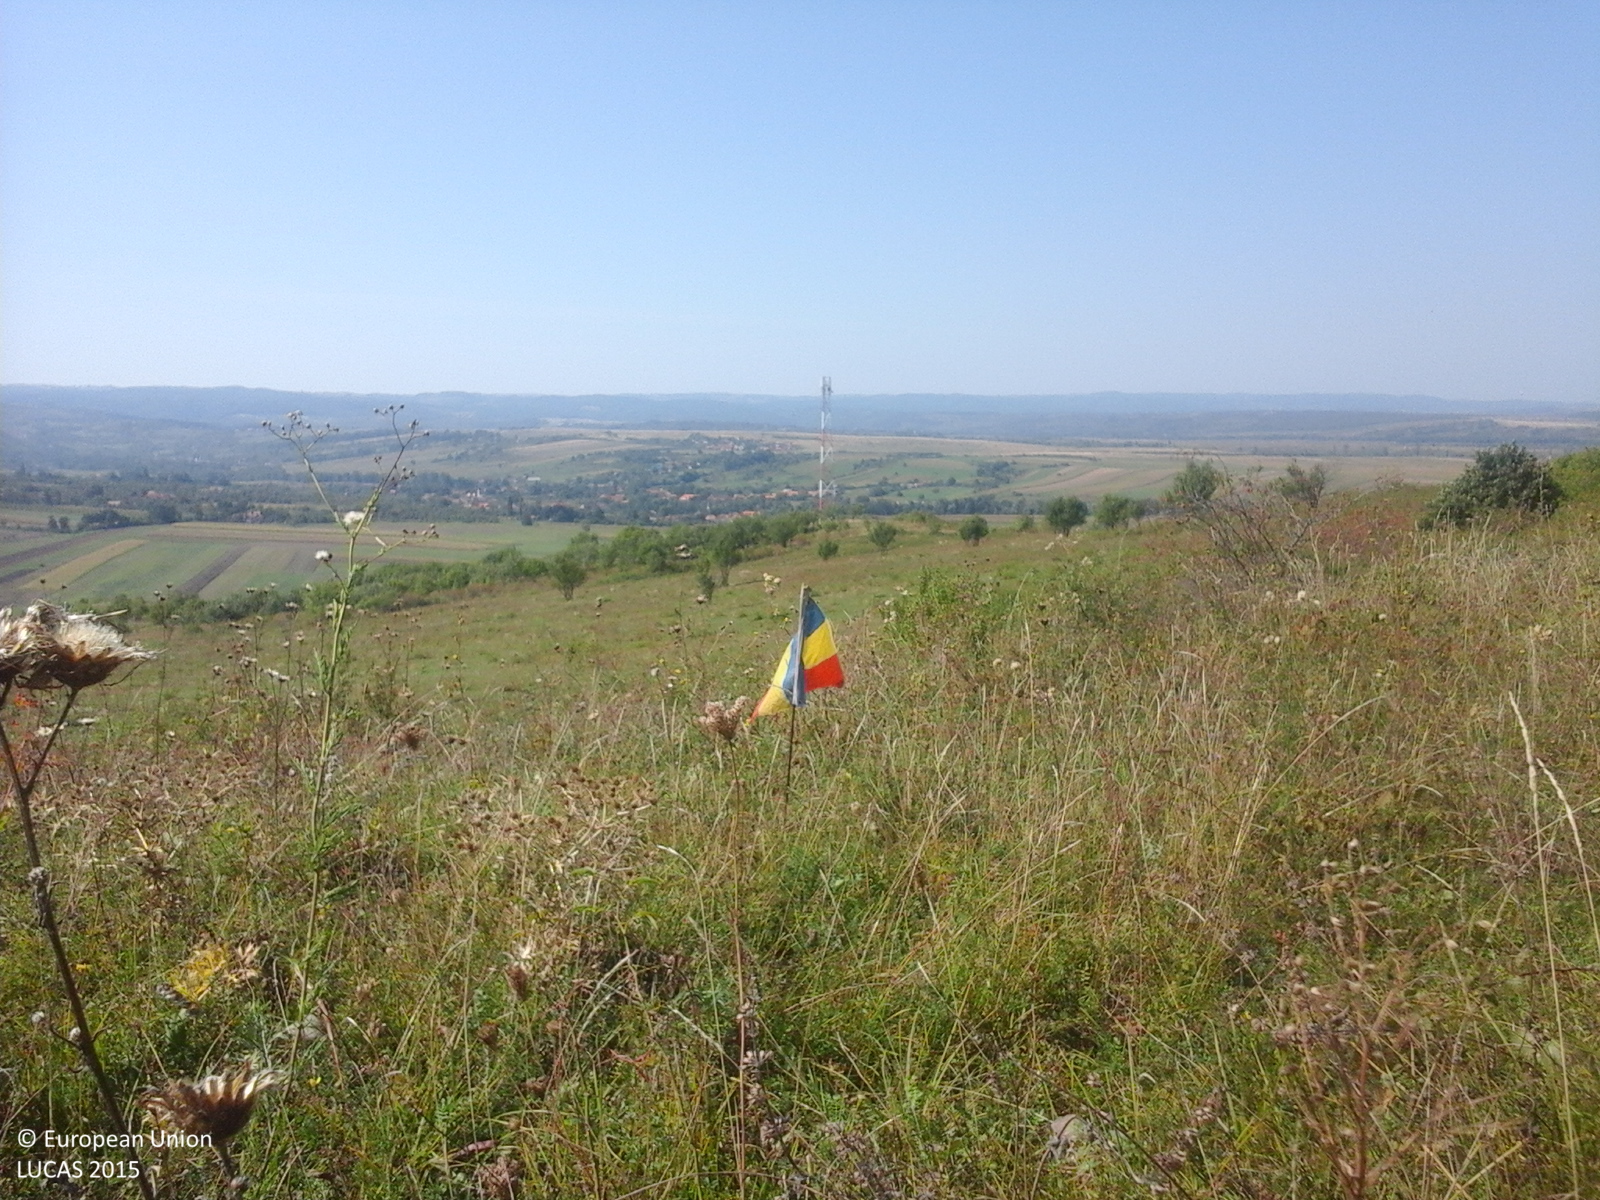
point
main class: Grassland
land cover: Grassland without tree/shrub cover
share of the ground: > 75 %
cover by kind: herbaceous plants 100 %
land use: Agriculture (excluding fallow land and kitchen gardens)
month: September
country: RO
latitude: 47.1152
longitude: 22.7506
